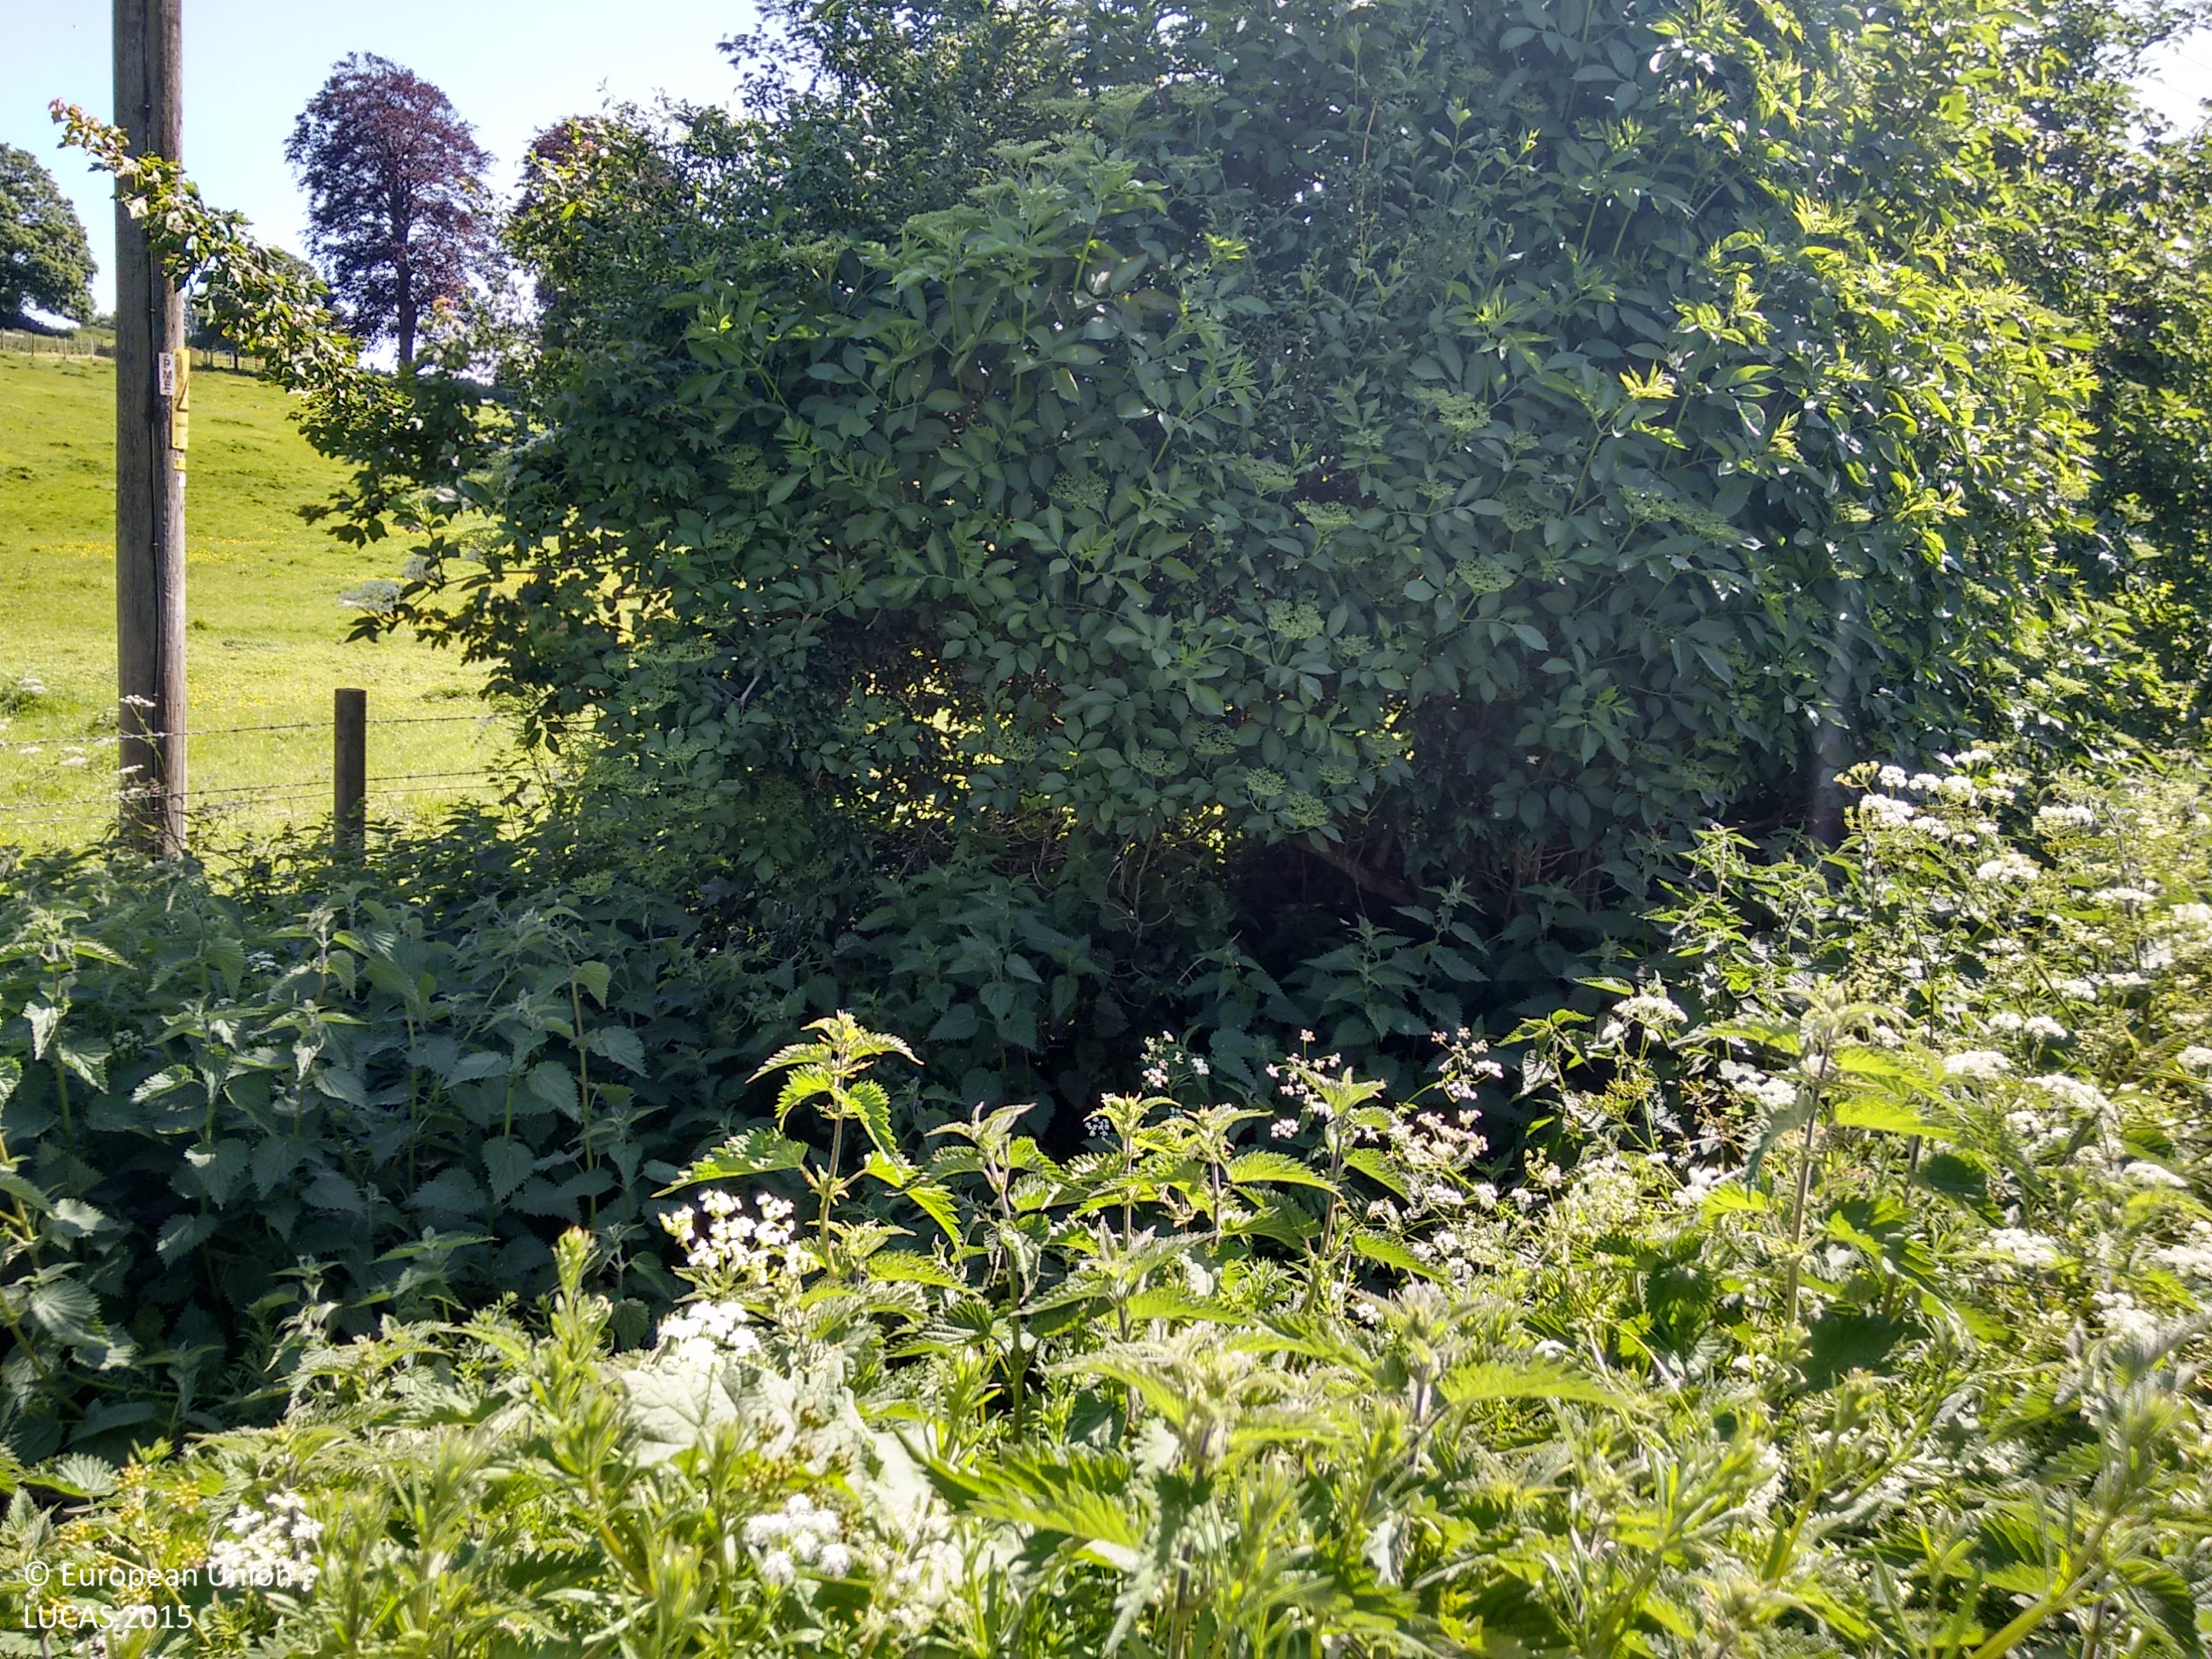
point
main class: Grassland
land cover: Spontaneously vegetated surfaces
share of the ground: > 75 %
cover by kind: herbaceous plants 95 %, shrubs 5 %
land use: Abandoned areas
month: June
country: GB
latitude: 50.7231
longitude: -2.4025
